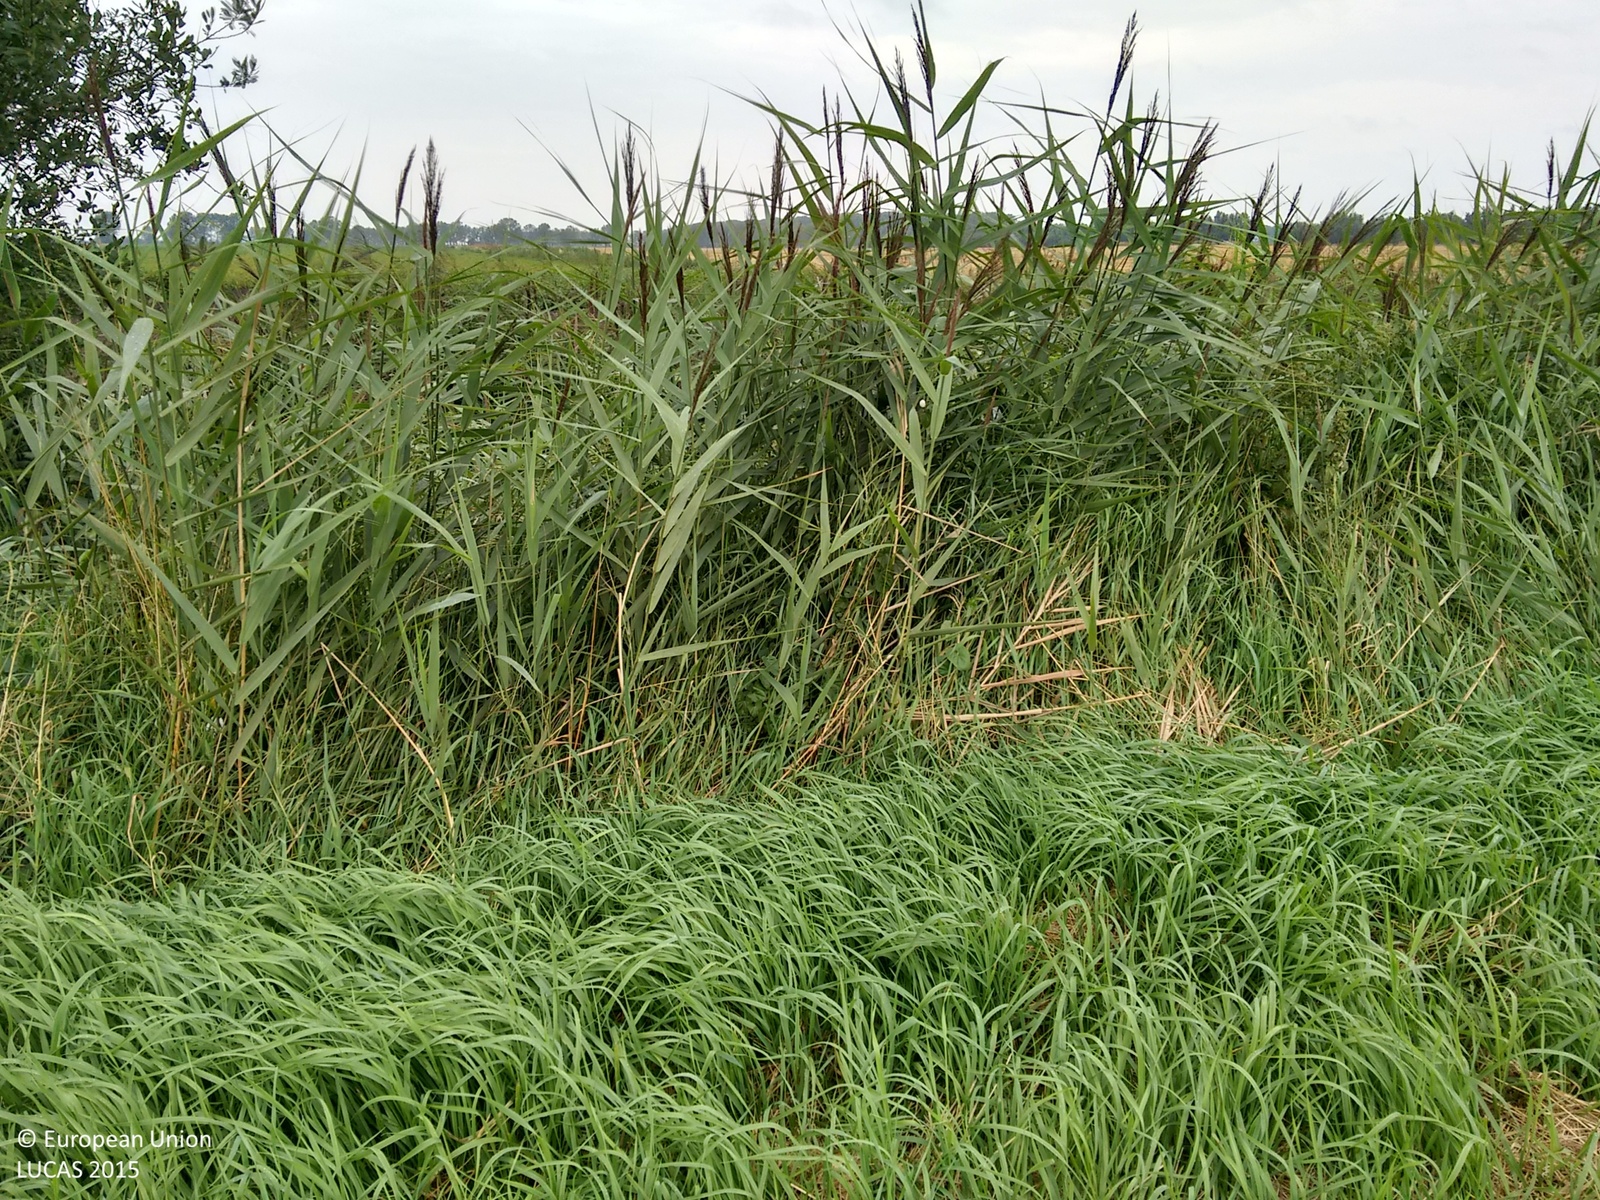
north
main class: Grassland
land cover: Grassland without tree/shrub cover
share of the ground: > 75 %
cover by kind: herbaceous plants 100 %
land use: Agriculture (excluding fallow land and kitchen gardens)
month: August
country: GB
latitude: 52.3841
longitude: 0.3773
